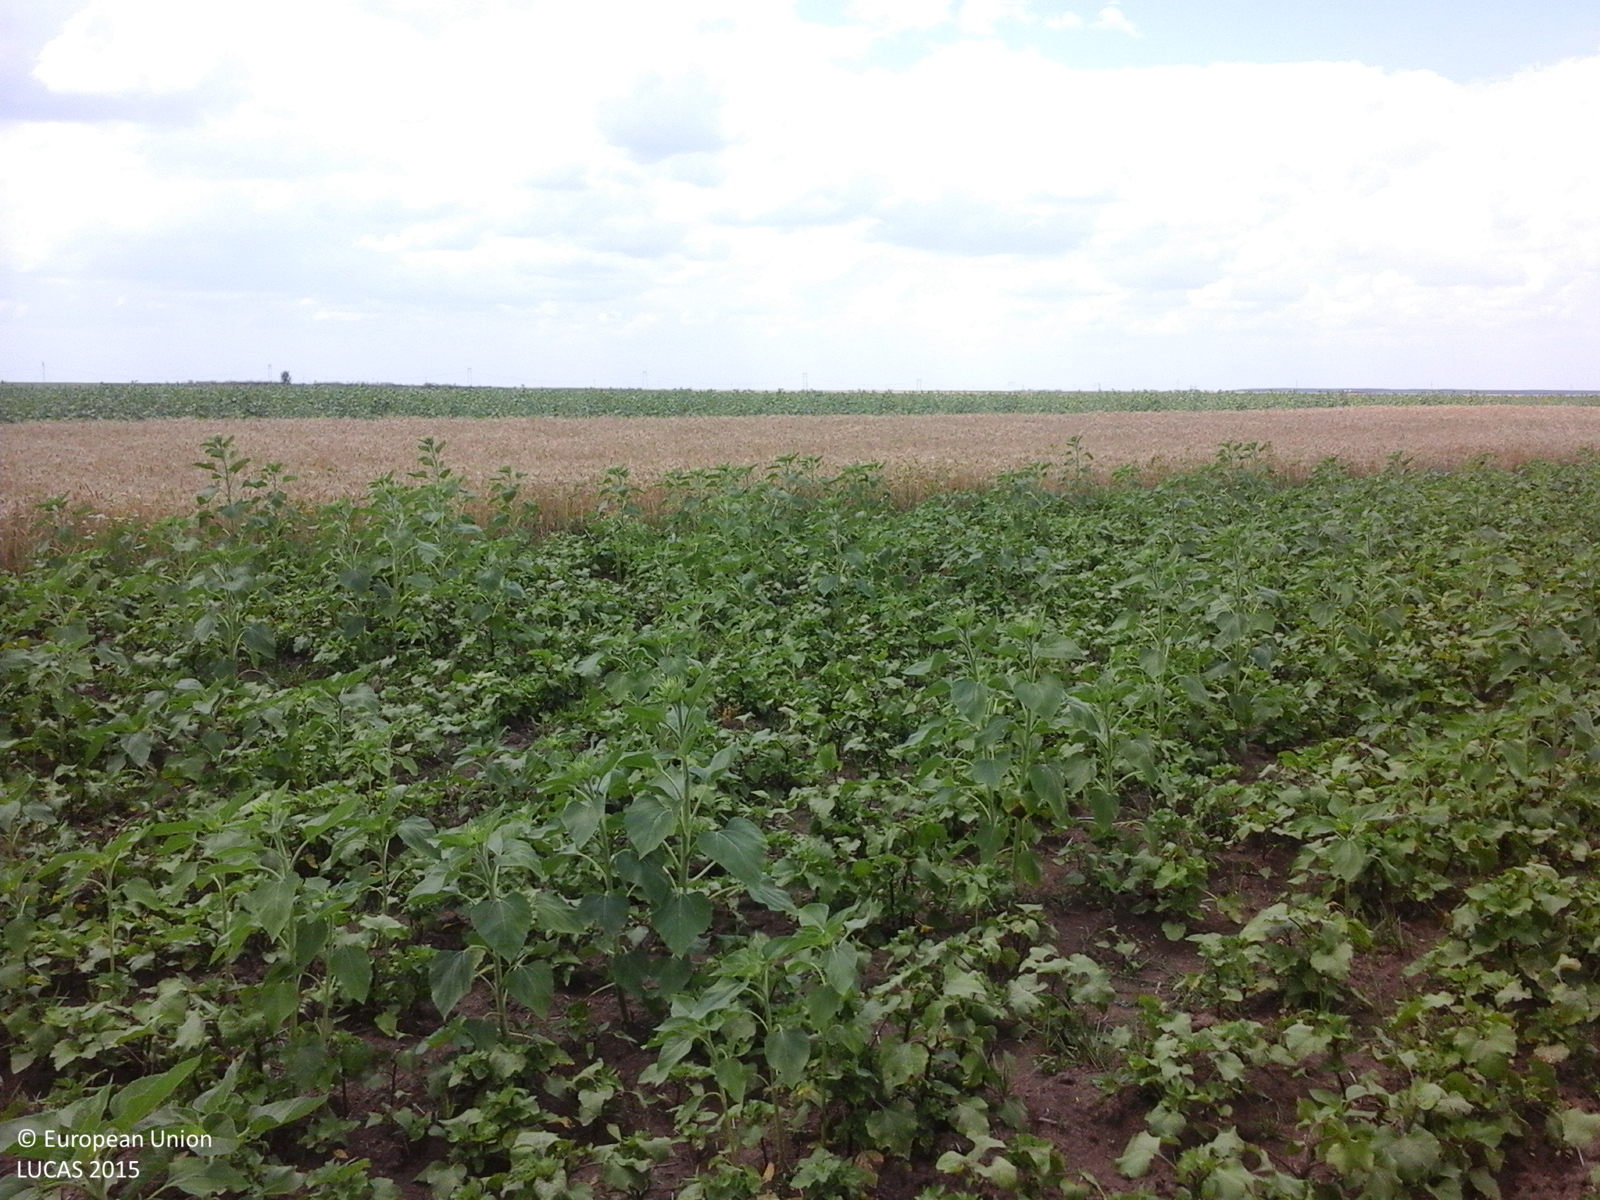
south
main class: Cropland
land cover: Sunflower
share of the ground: > 75 %
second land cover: Spontaneously vegetated surfaces
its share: > 75 %
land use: Agriculture (excluding fallow land and kitchen gardens)
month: July
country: RO
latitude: 44.2738
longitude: 25.2821
